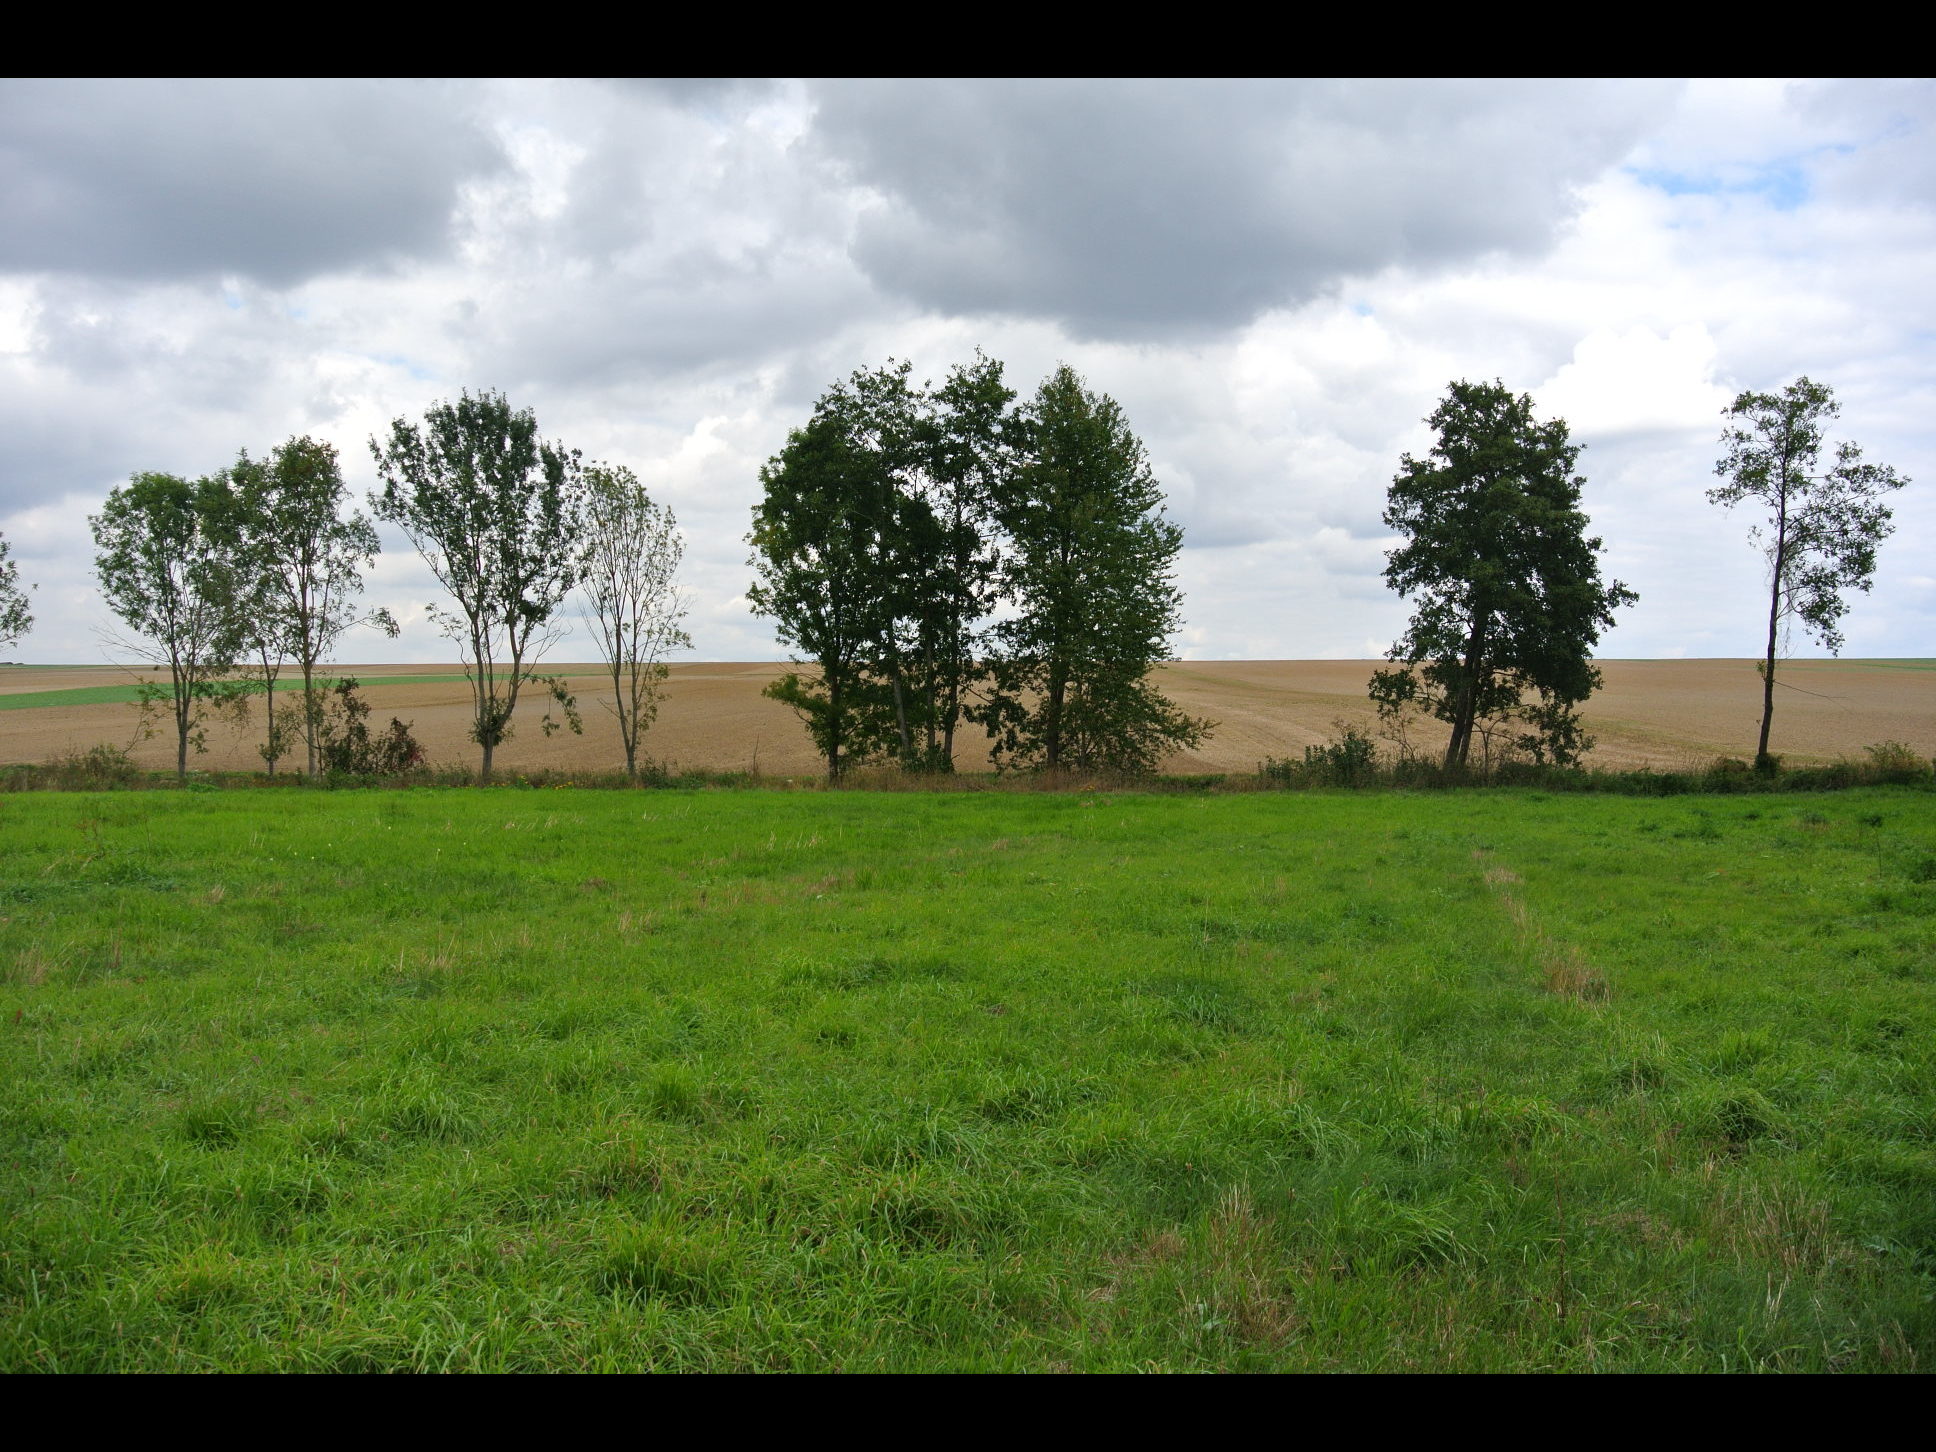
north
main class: Grassland
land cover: Grassland without tree/shrub cover
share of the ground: > 75 %
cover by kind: herbaceous plants 100 %
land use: Agriculture (excluding fallow land and kitchen gardens)
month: July
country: AT
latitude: 47.4951
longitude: 16.4148
